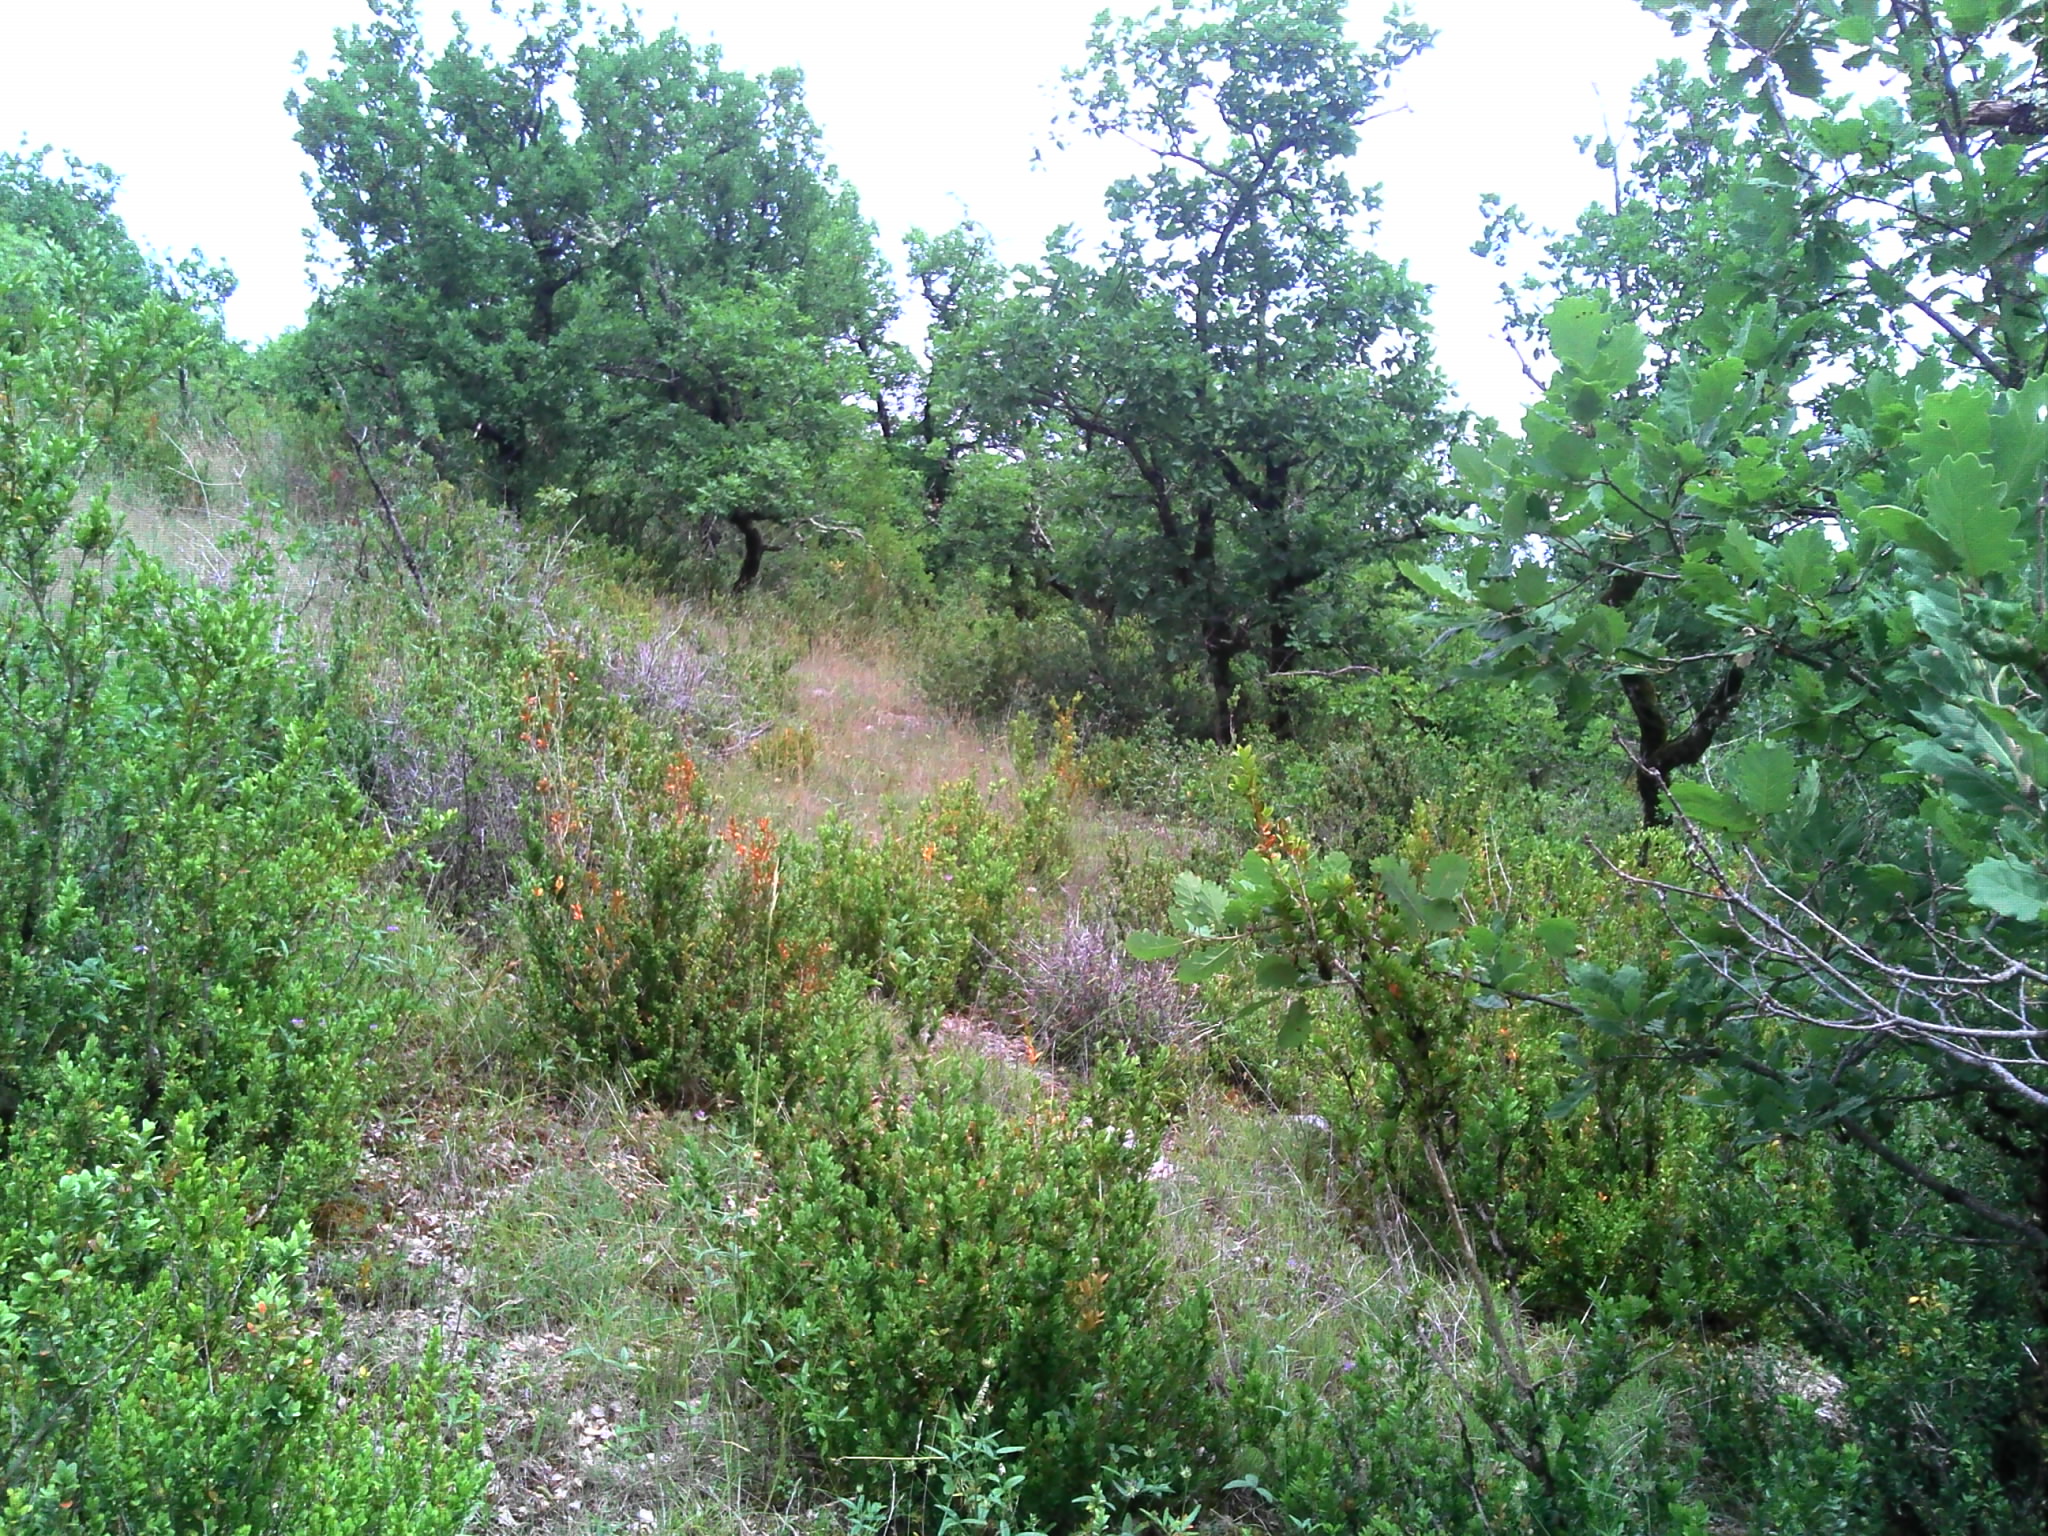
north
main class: Woodland
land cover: Broadleaved woodland
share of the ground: > 75 %
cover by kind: broadleaved forest trees 95 %, herbaceous plants 5 %
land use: Semi-natural and natural areas not in use
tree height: < 5 m
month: June
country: FR
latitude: 44.4378
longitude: 1.5182
